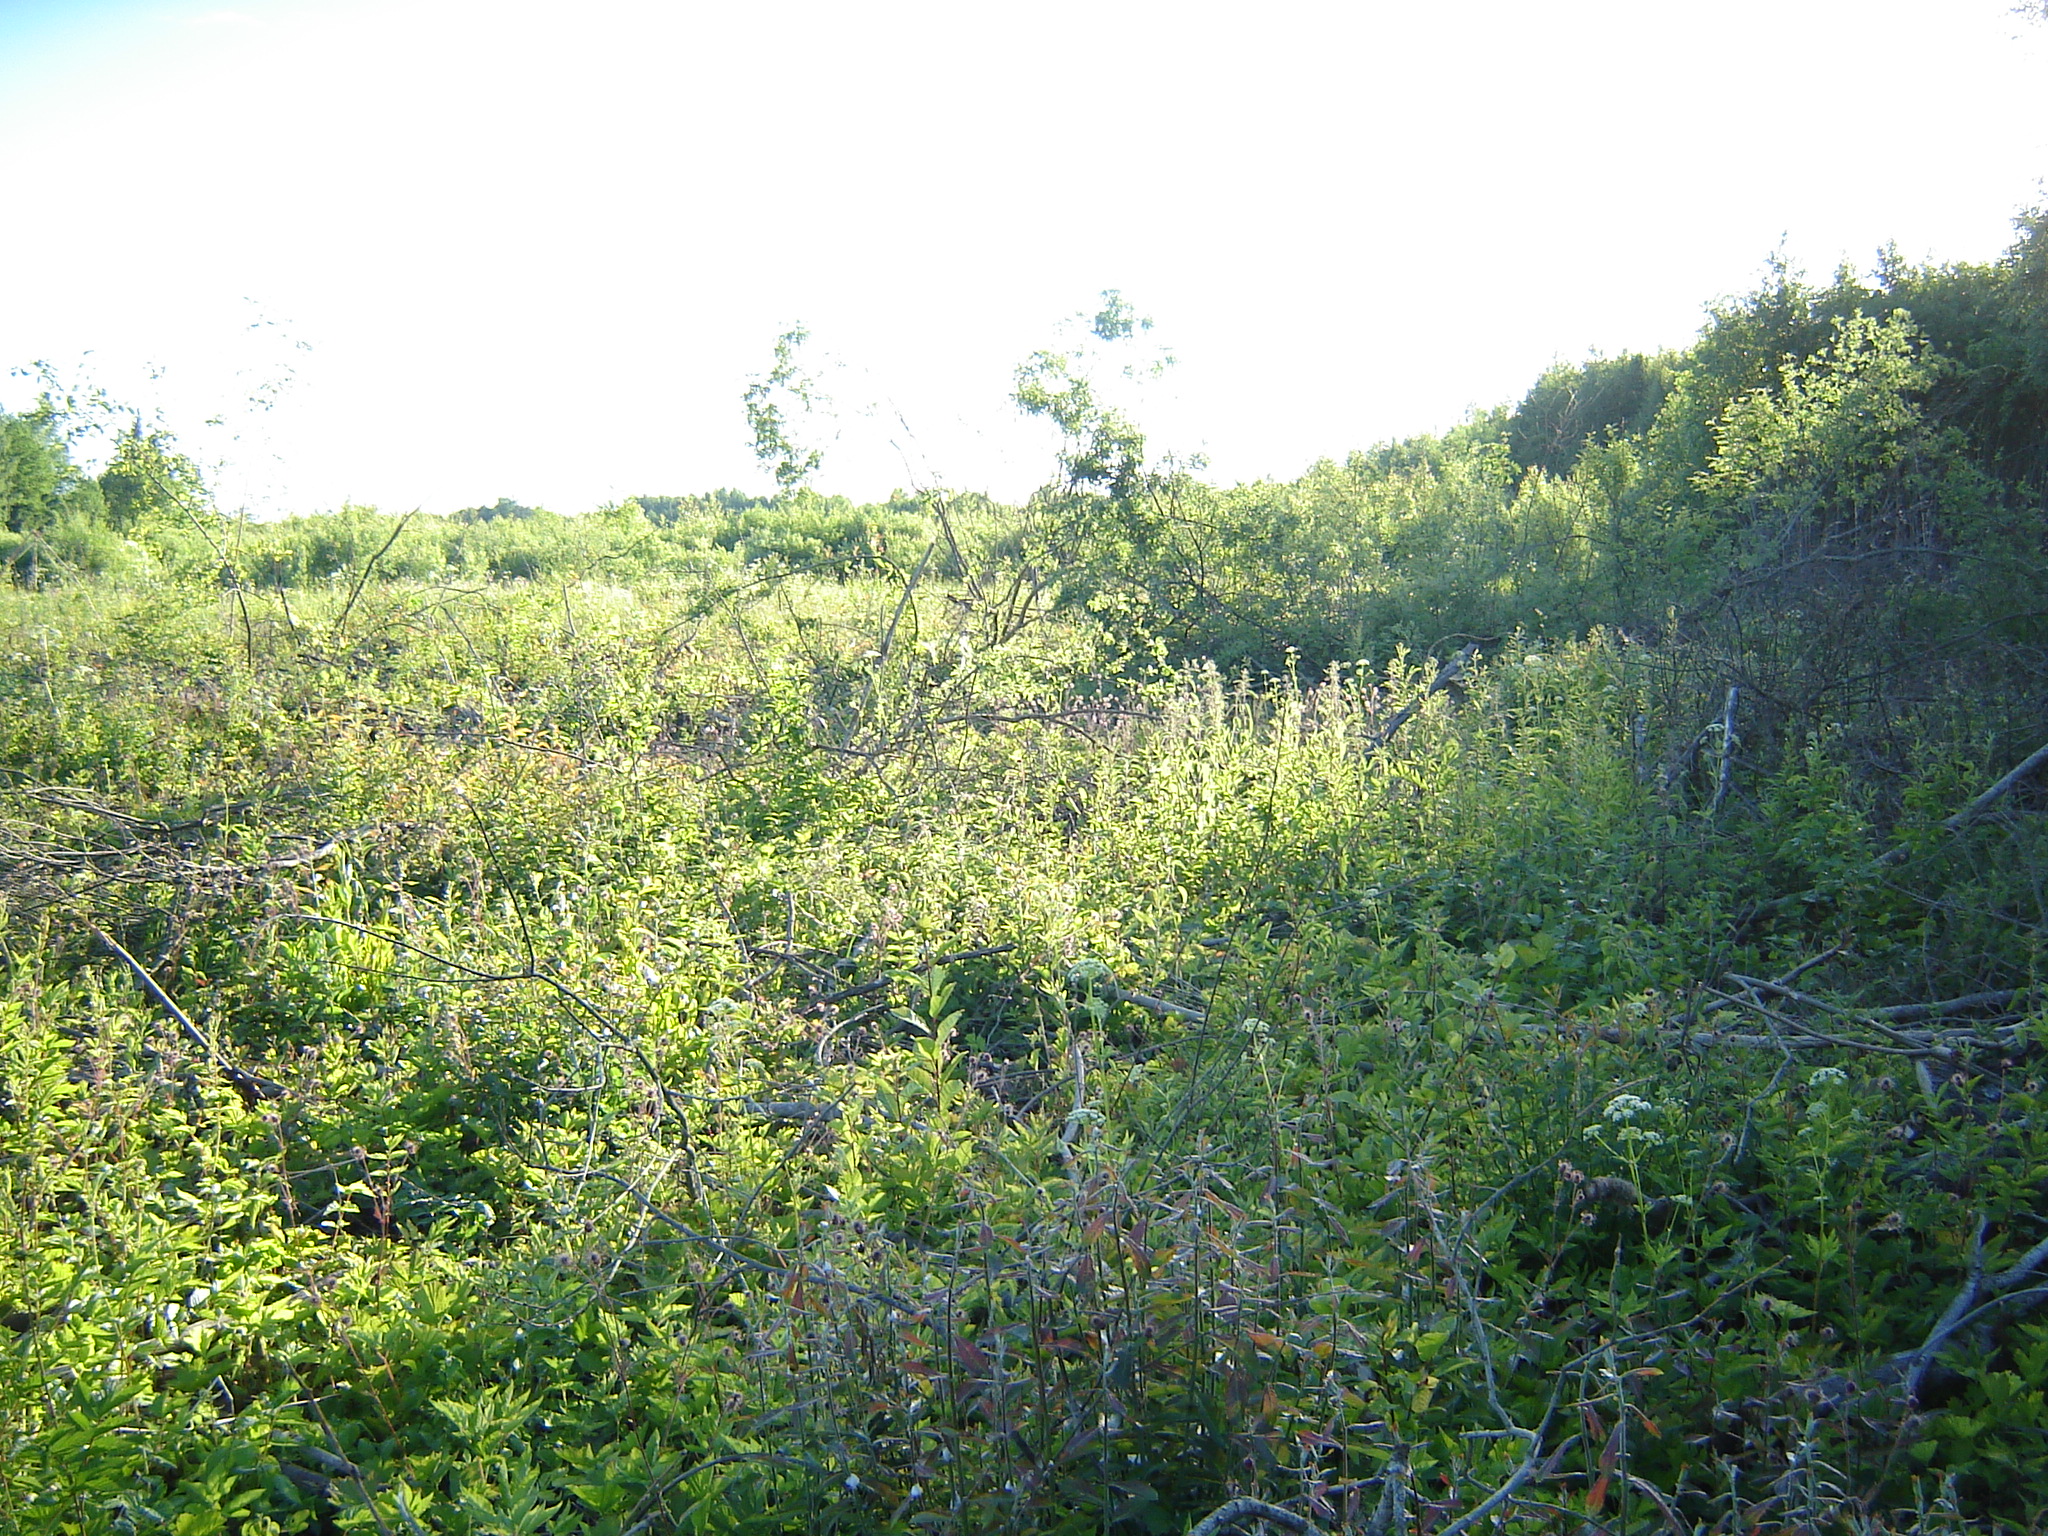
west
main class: Woodland
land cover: Broadleaved woodland
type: mire and swamp forests
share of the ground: > 75 %
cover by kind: broadleaved forest trees 75 %, shrubs 15 %, herbaceous plants 10 %
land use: Forestry
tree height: < 5 m
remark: Clear cut
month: June
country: LT
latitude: 55.5500
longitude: 24.7356
